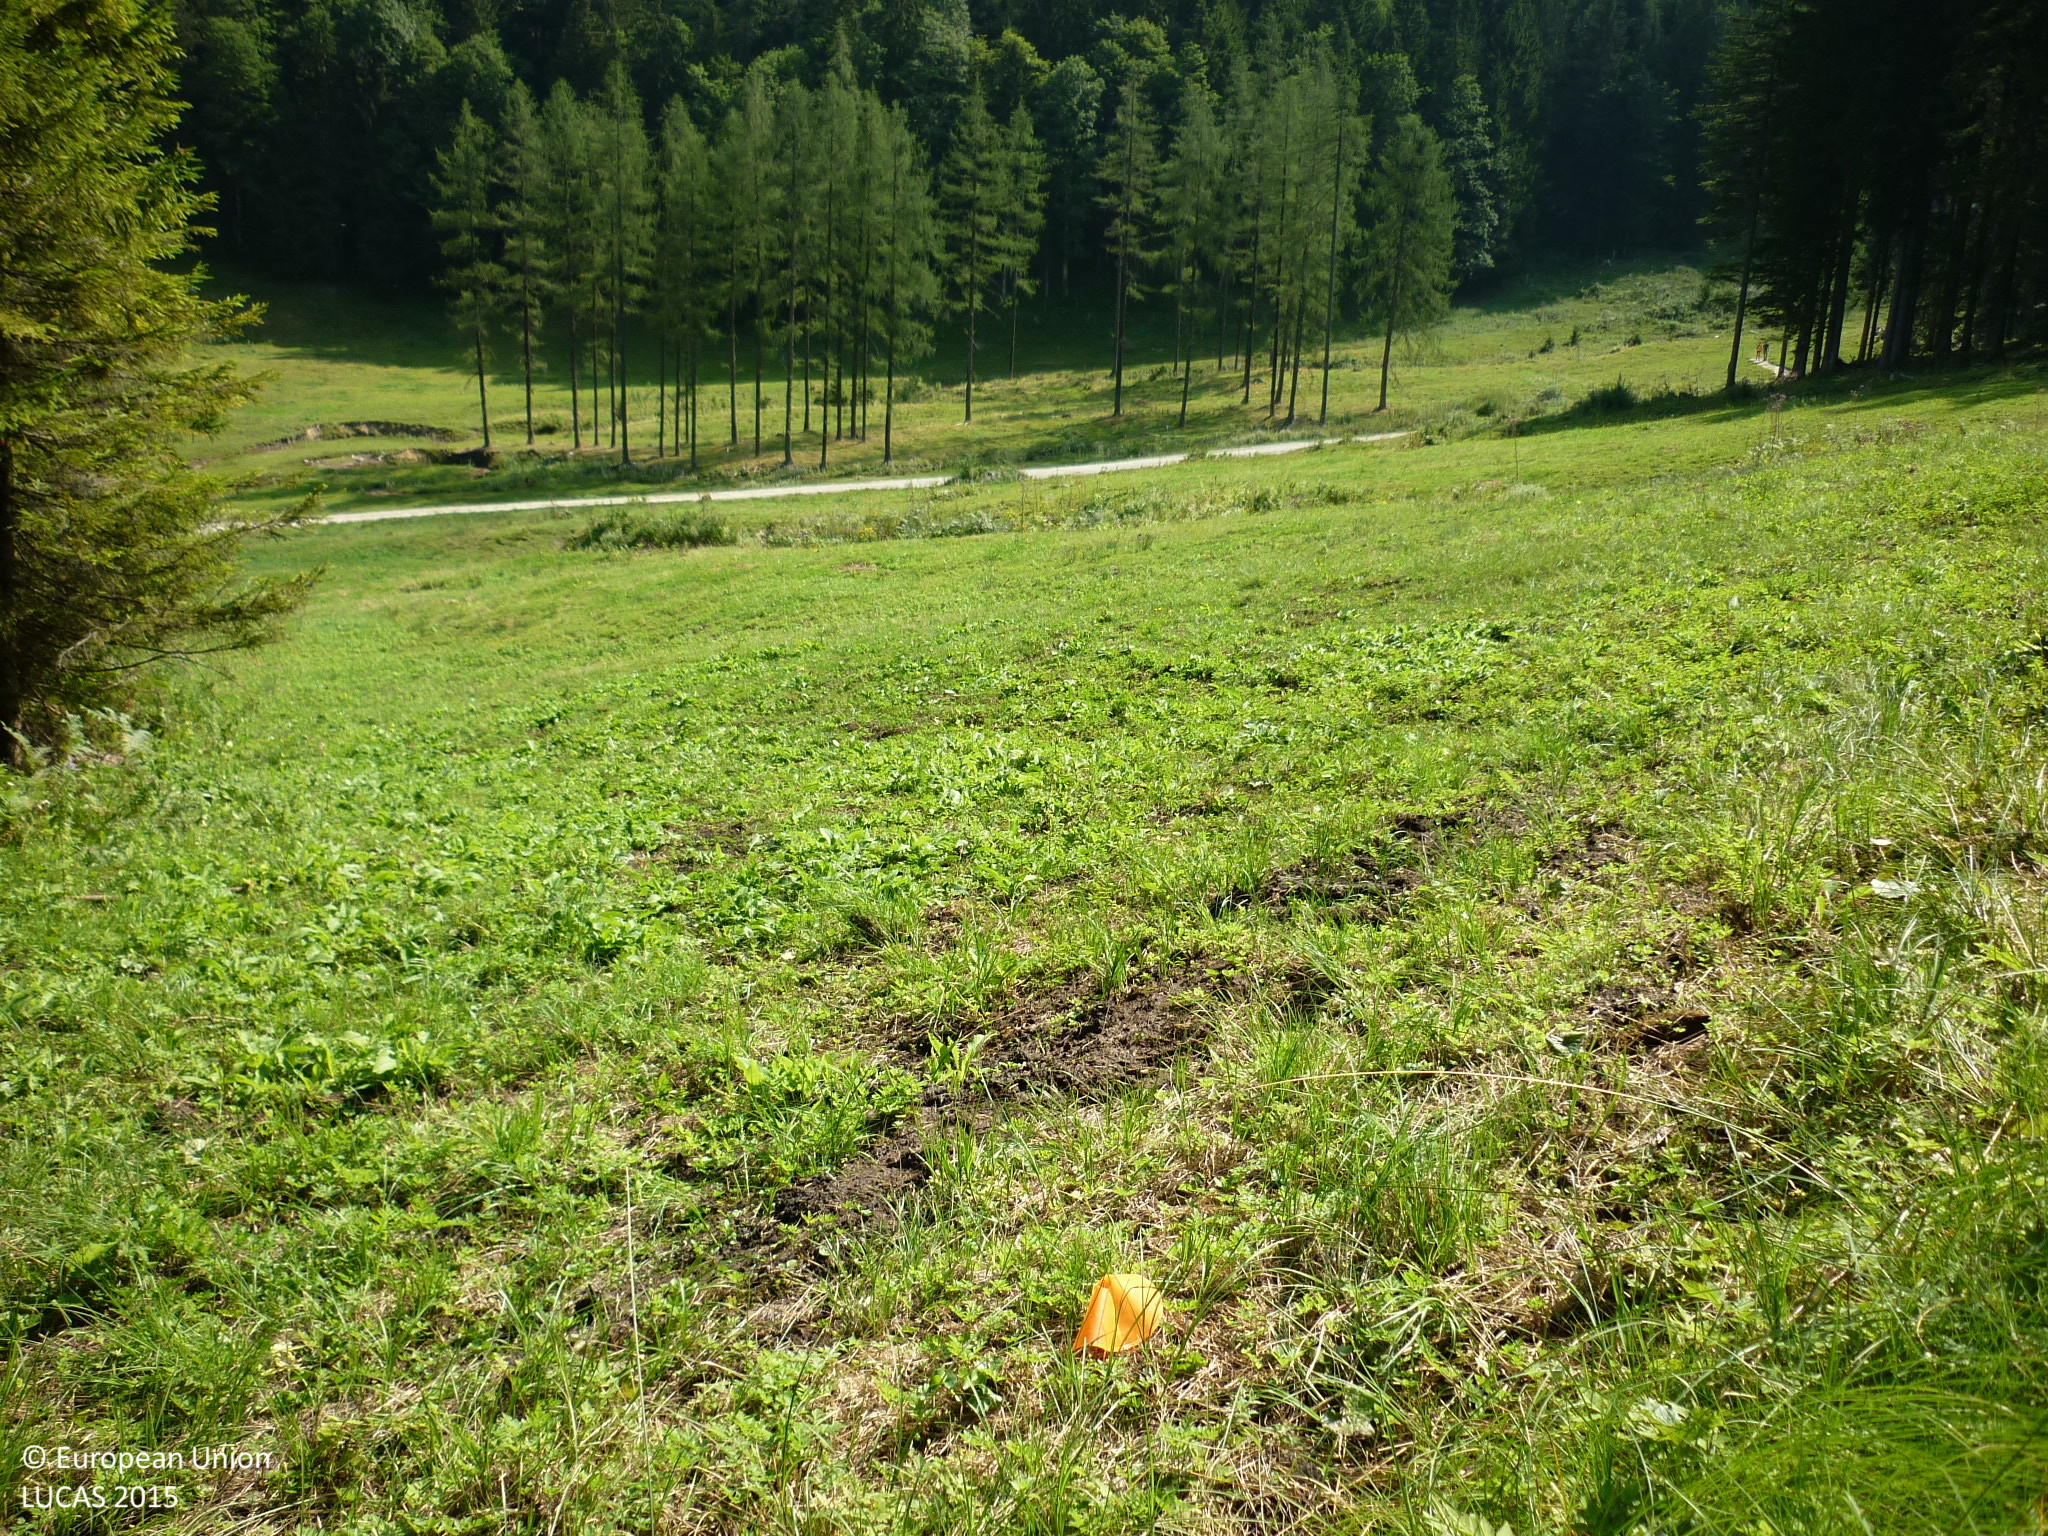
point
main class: Grassland
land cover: Grassland without tree/shrub cover
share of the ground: > 75 %
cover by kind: herbaceous plants 100 %
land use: Agriculture (excluding fallow land and kitchen gardens)
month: August
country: AT
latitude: 47.6679
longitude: 14.3808
